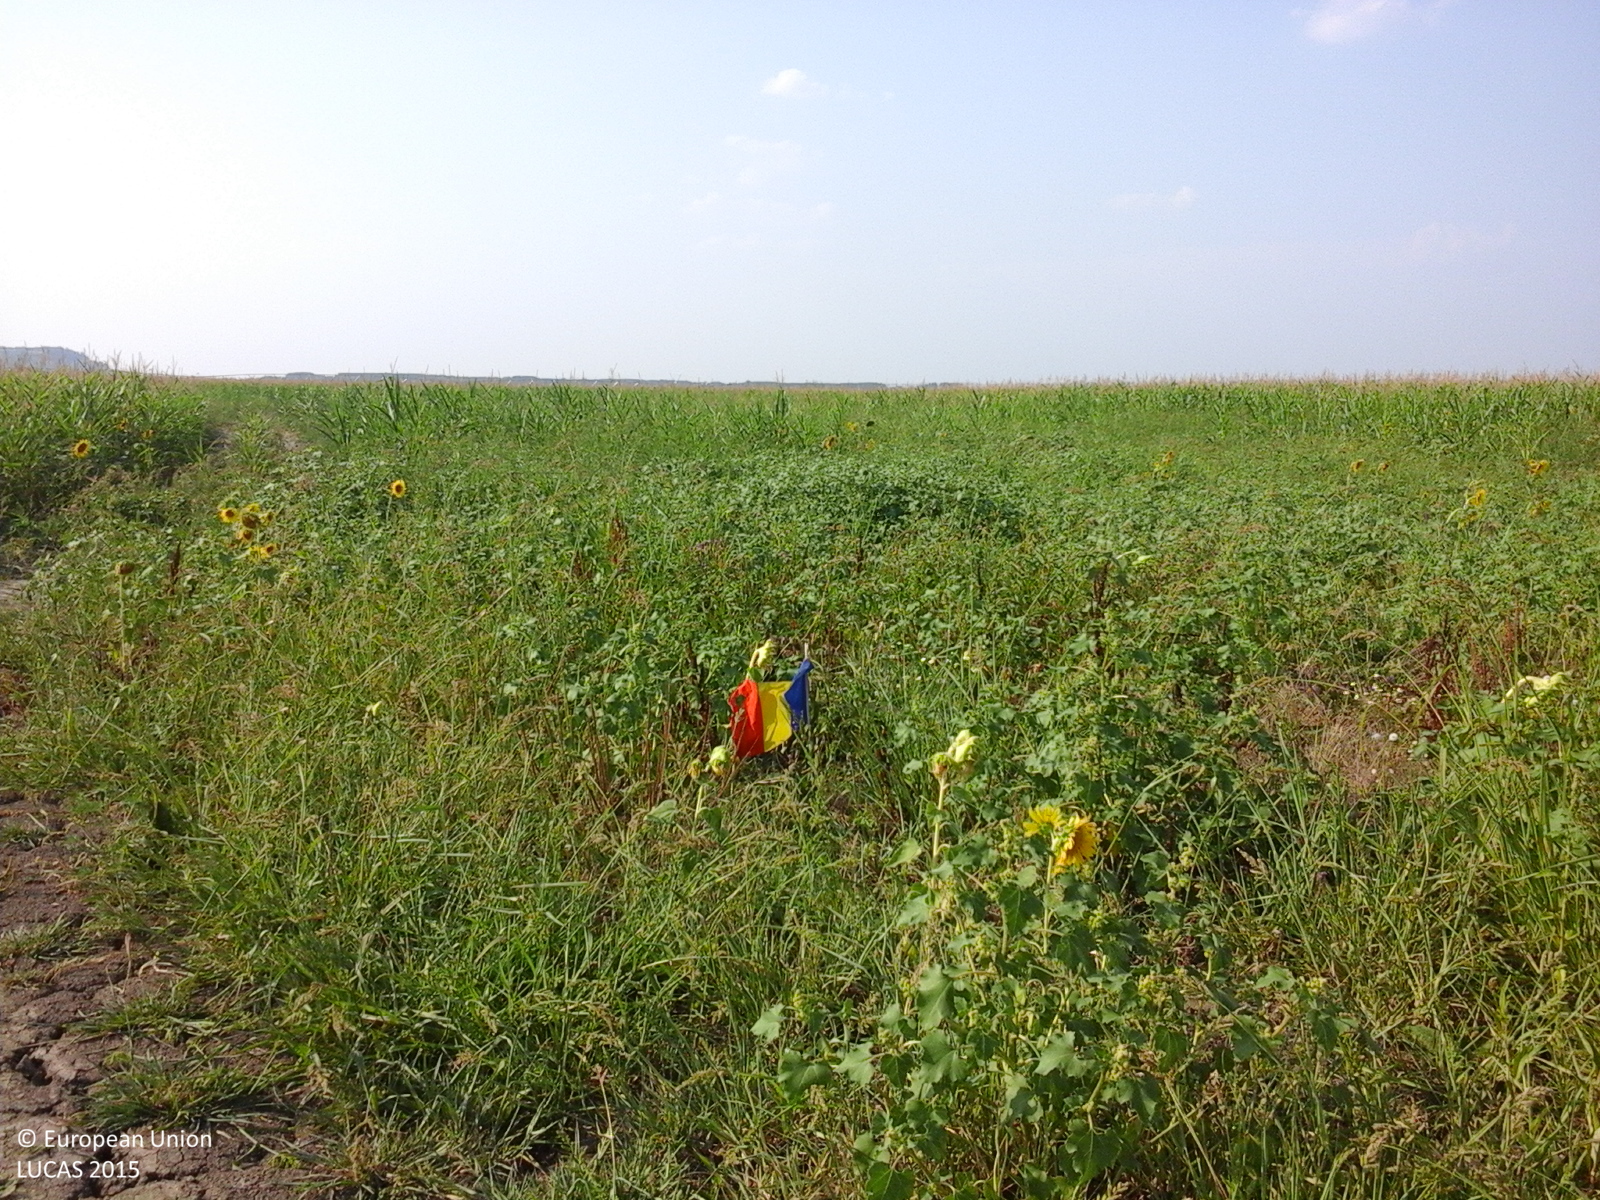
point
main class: Grassland
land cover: Spontaneously vegetated surfaces
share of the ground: > 75 %
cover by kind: herbaceous plants 100 %
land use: Agriculture (excluding fallow land and kitchen gardens)
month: August
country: RO
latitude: 44.3903
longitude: 23.6758
